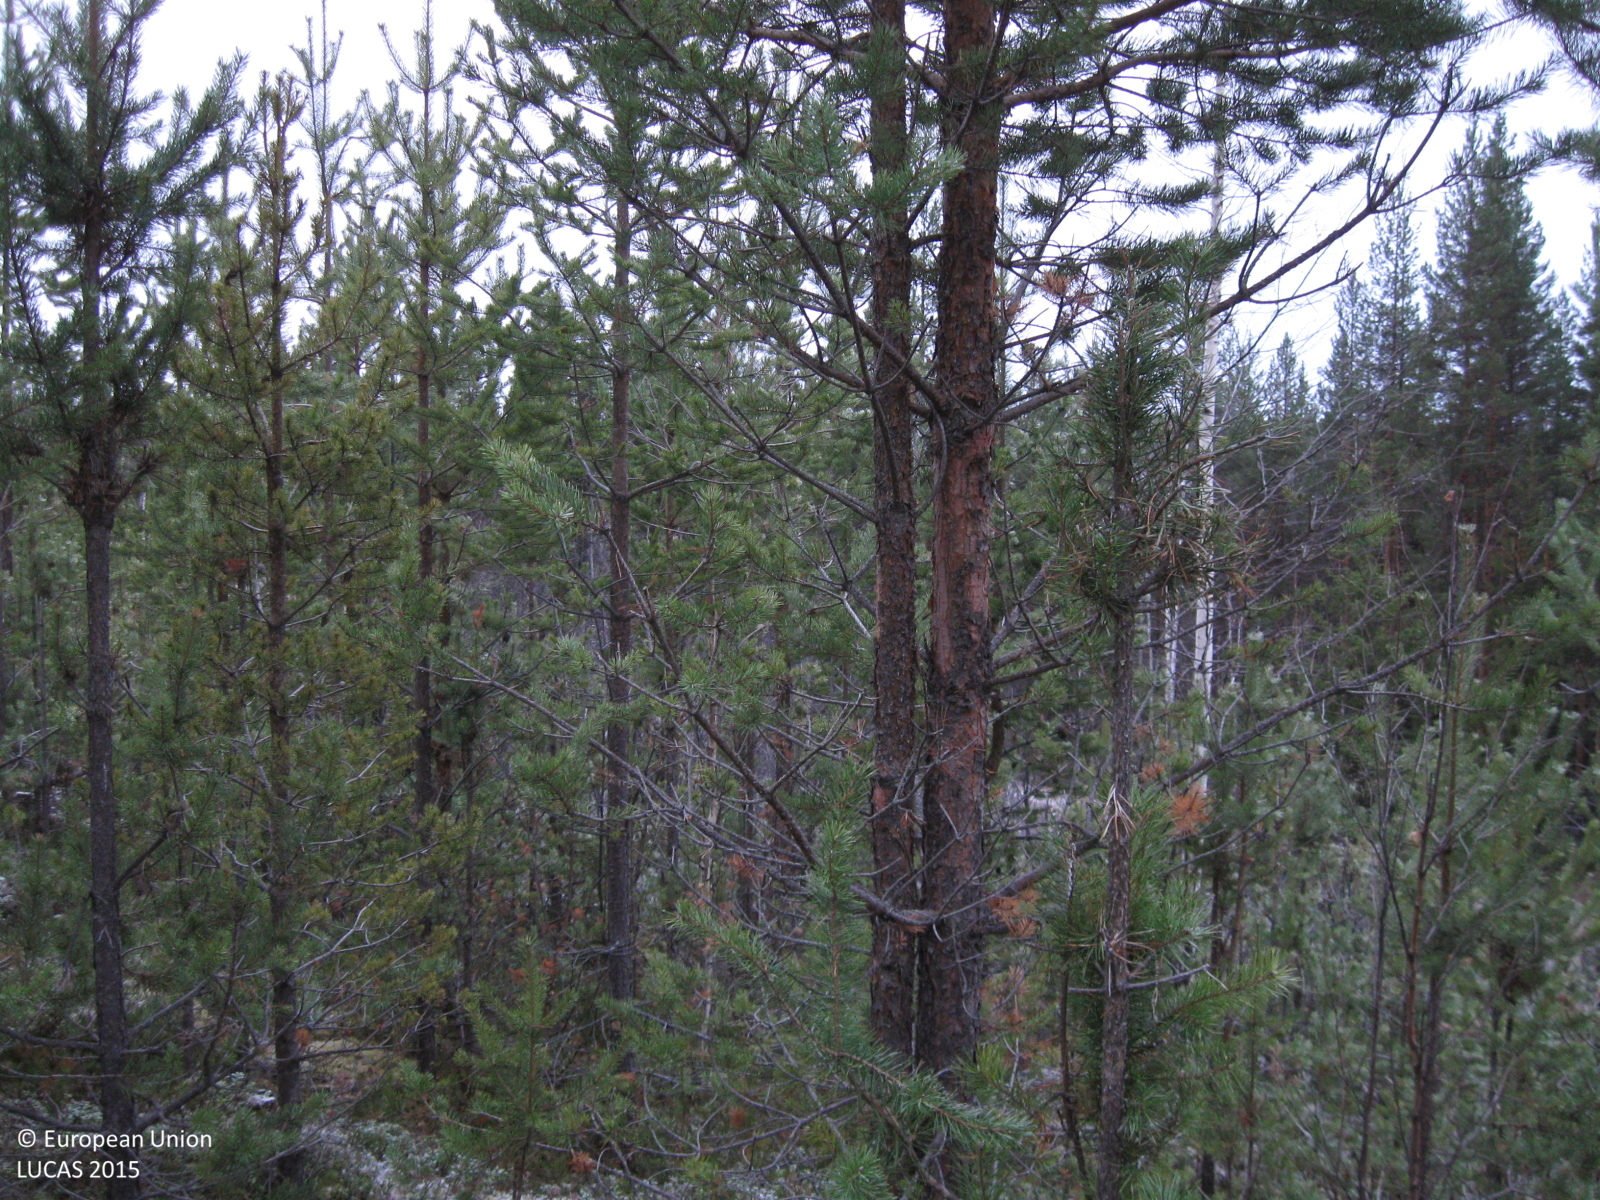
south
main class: Woodland
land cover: Pine dominated coniferous woodland
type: boreal forest
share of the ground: > 75 %
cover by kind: coniferous forest trees 80 %, broadleaved forest trees 5 %, shrubs 5 %, herbaceous plants 5 %, lichens and mosses 5 %
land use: Forestry
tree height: < 5 m
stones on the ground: 25 - 50 %
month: October
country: SE
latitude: 66.2296
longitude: 20.9674
